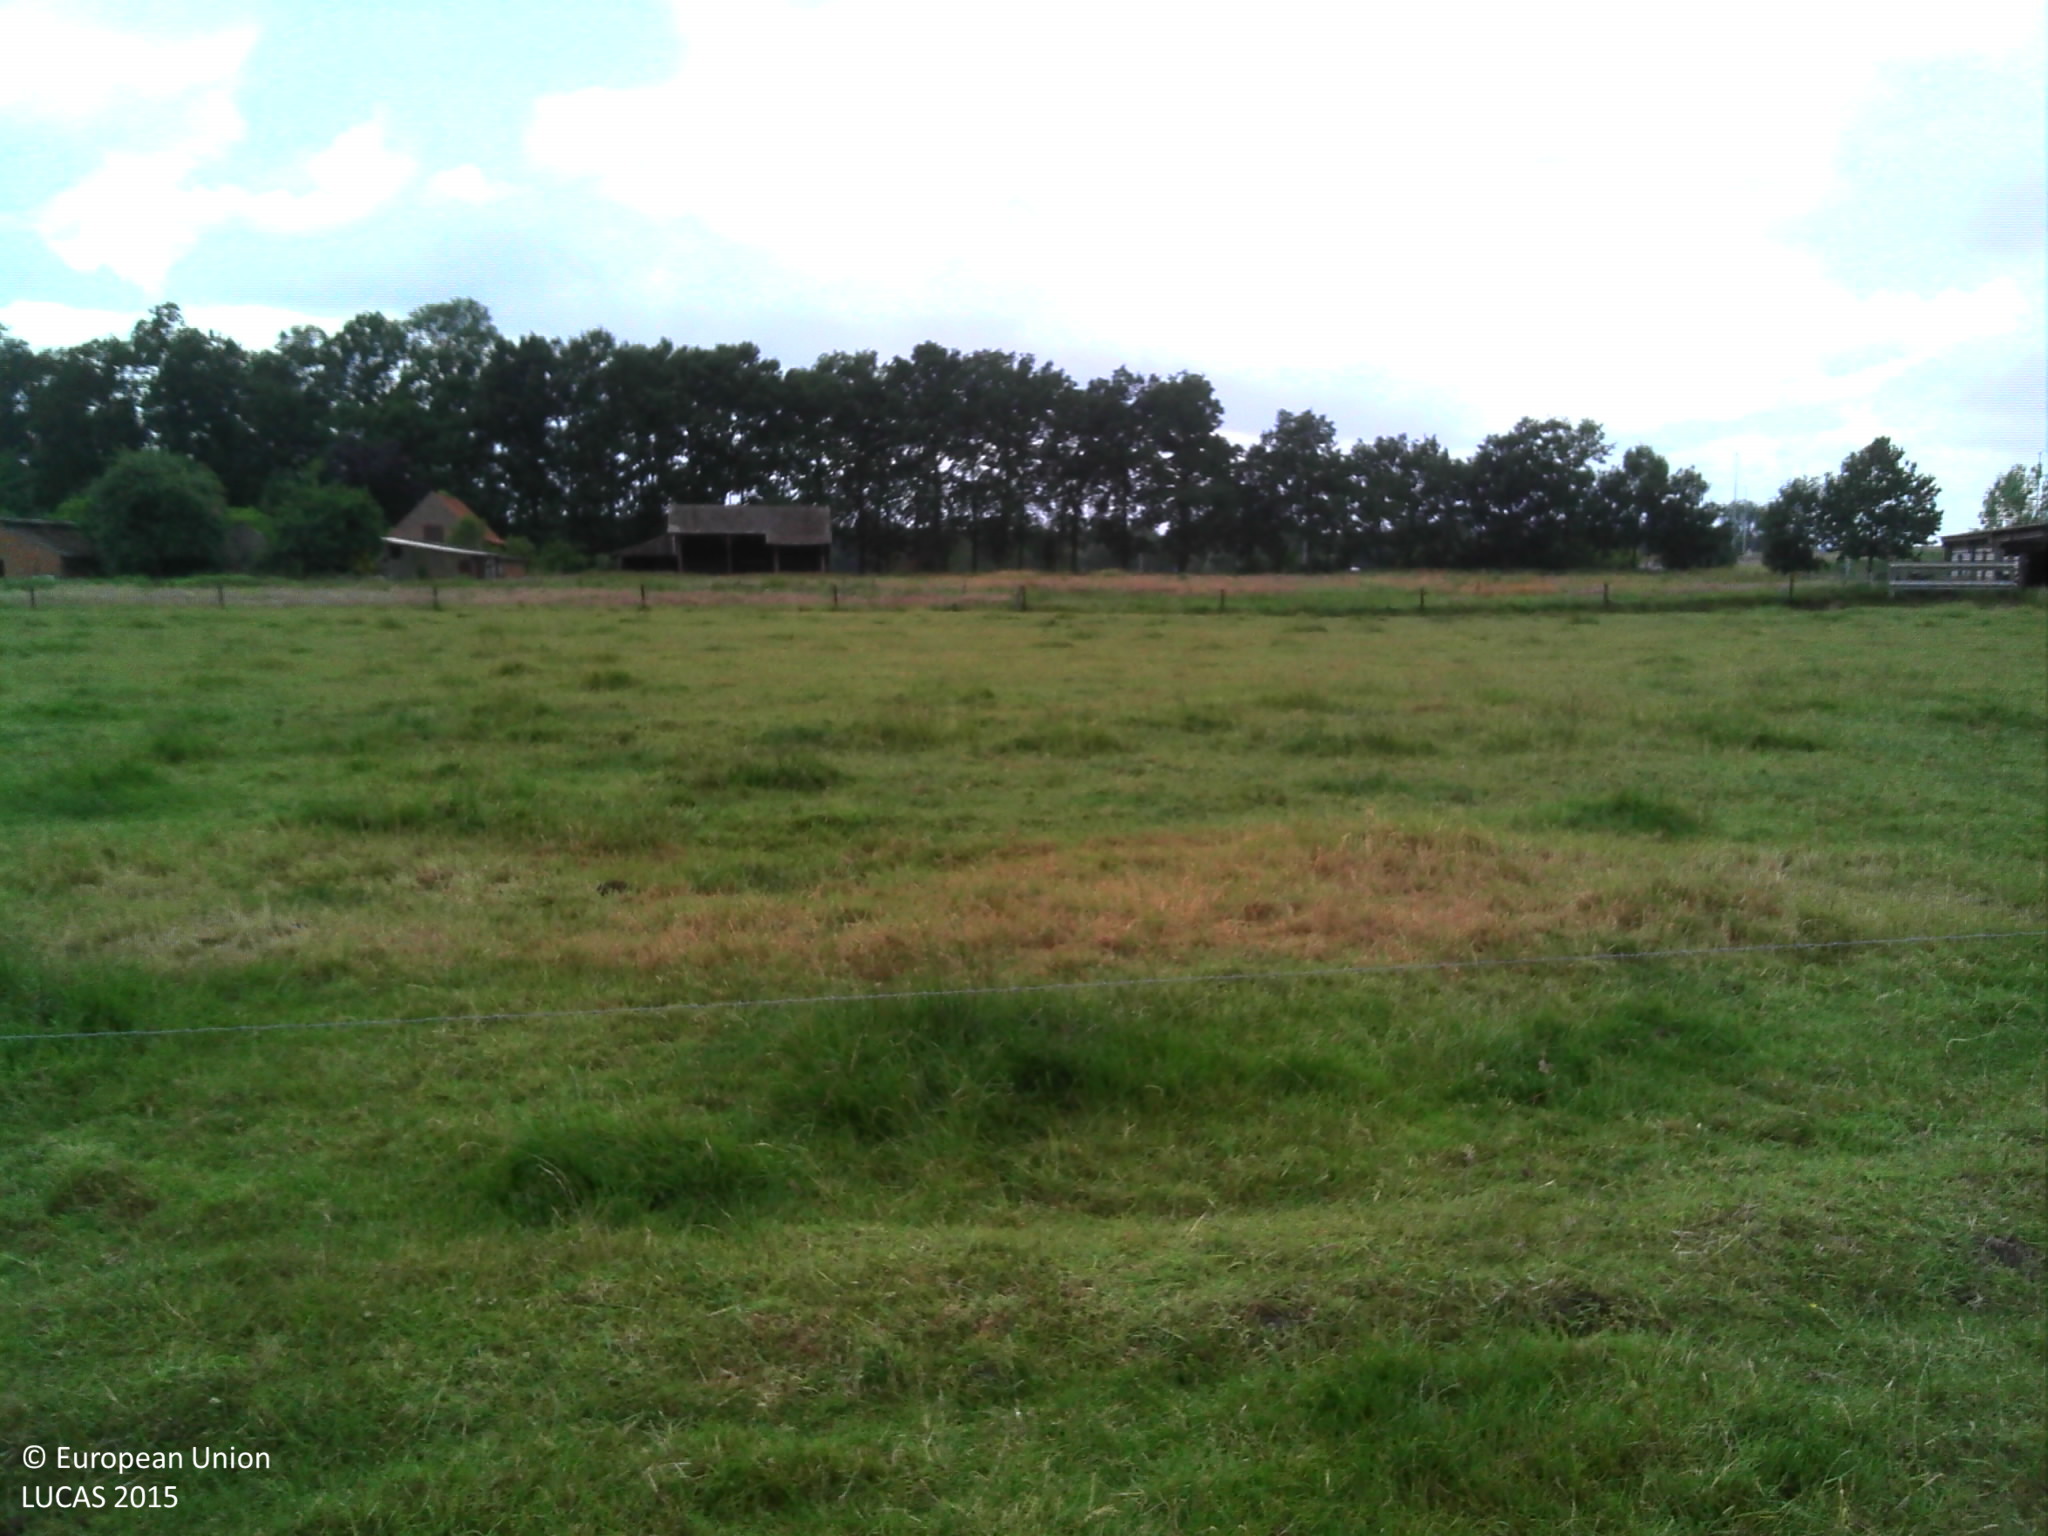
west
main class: Grassland
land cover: Grassland without tree/shrub cover
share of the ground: > 75 %
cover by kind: herbaceous plants 100 %
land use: Agriculture (excluding fallow land and kitchen gardens)
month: June
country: BE
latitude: 51.1951
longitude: 3.9408
